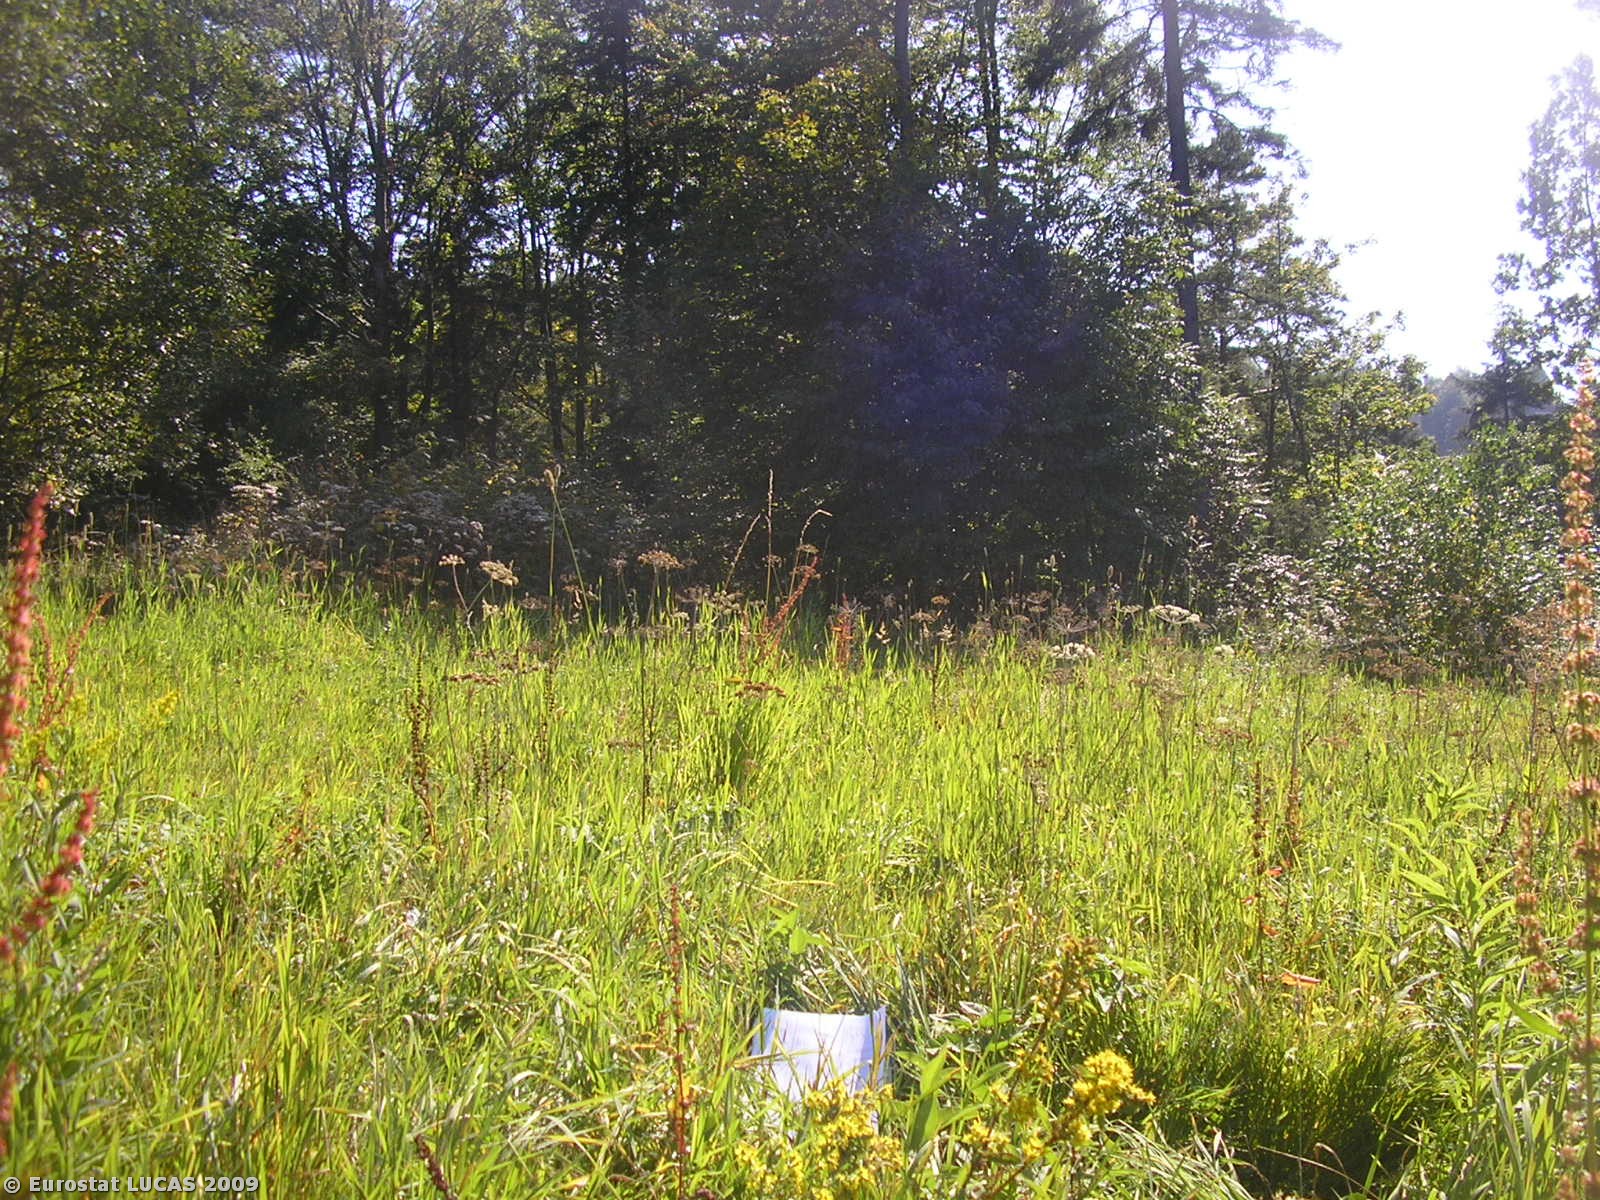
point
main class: Grassland
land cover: Grassland without tree/shrub cover
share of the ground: > 75 %
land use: Agriculture (excluding fallow land and kitchen gardens)
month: September
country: PL
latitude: 49.7537
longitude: 19.6753
